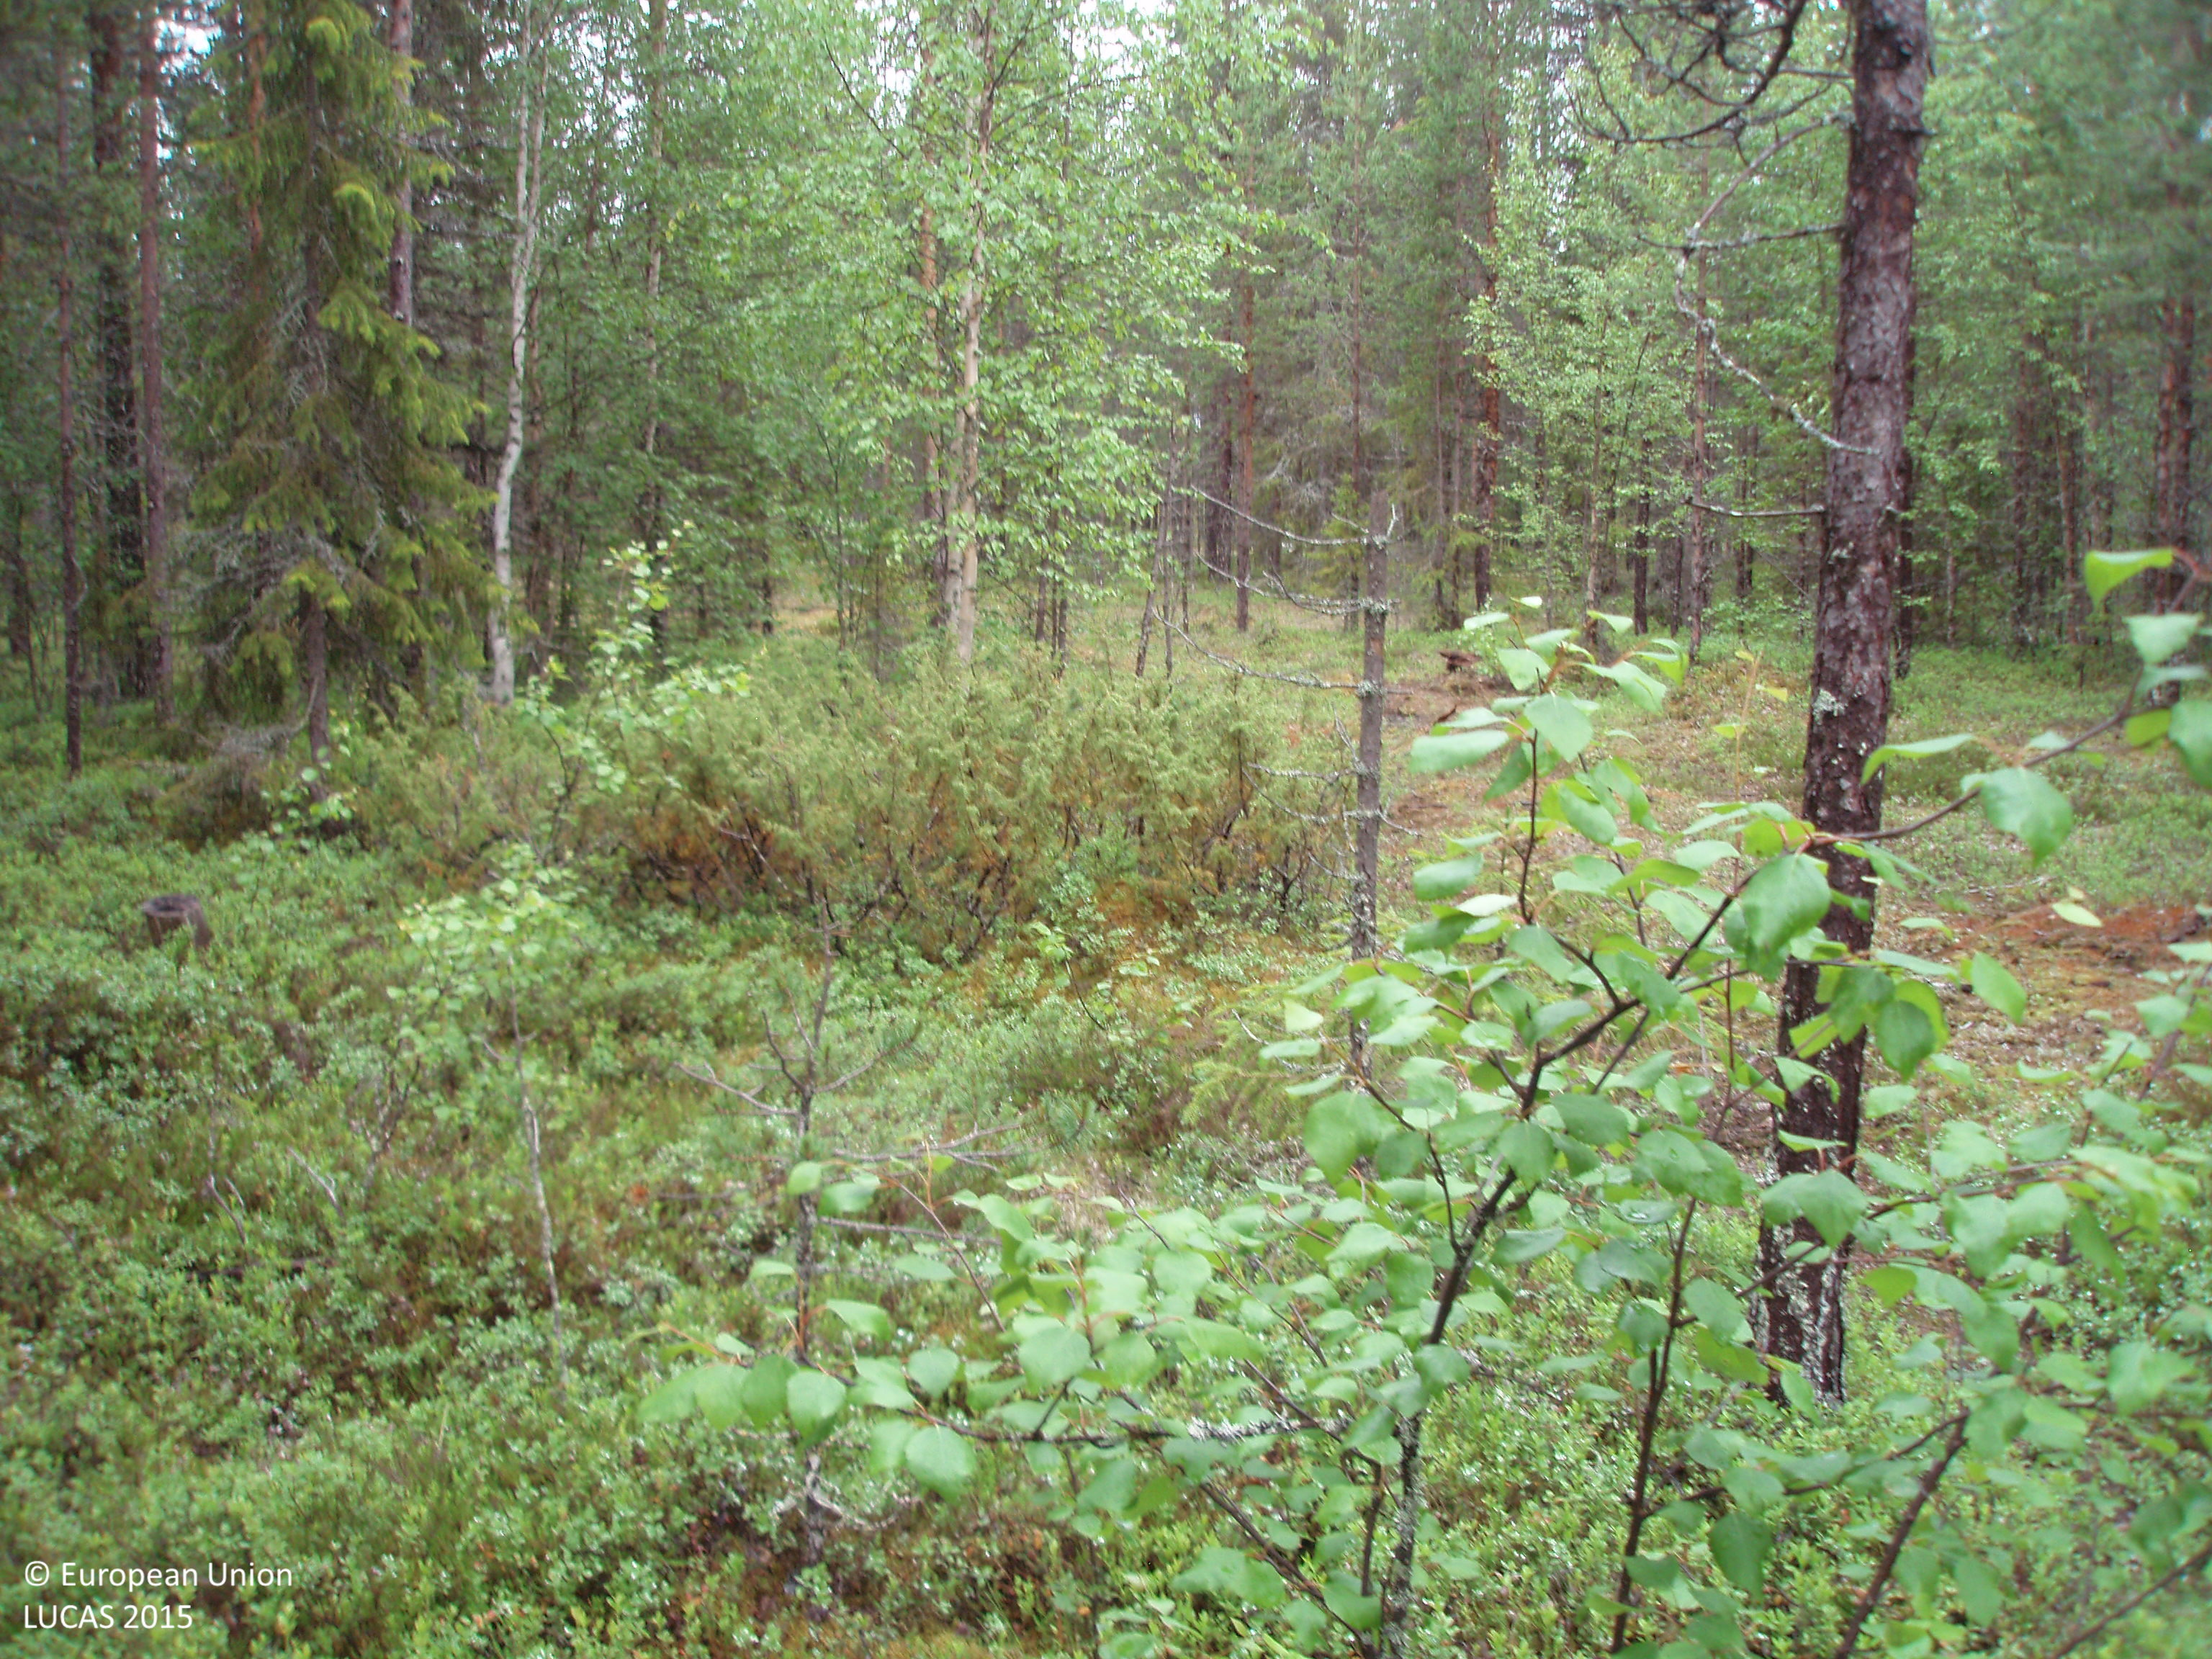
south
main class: Woodland
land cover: Pine dominated mixed woodland
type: boreal forest
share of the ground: > 75 %
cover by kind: coniferous forest trees 60 %, broadleaved forest trees 25 %, shrubs 15 %
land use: Forestry
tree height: > 5 m
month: July
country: FI
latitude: 67.0908
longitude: 28.8638
